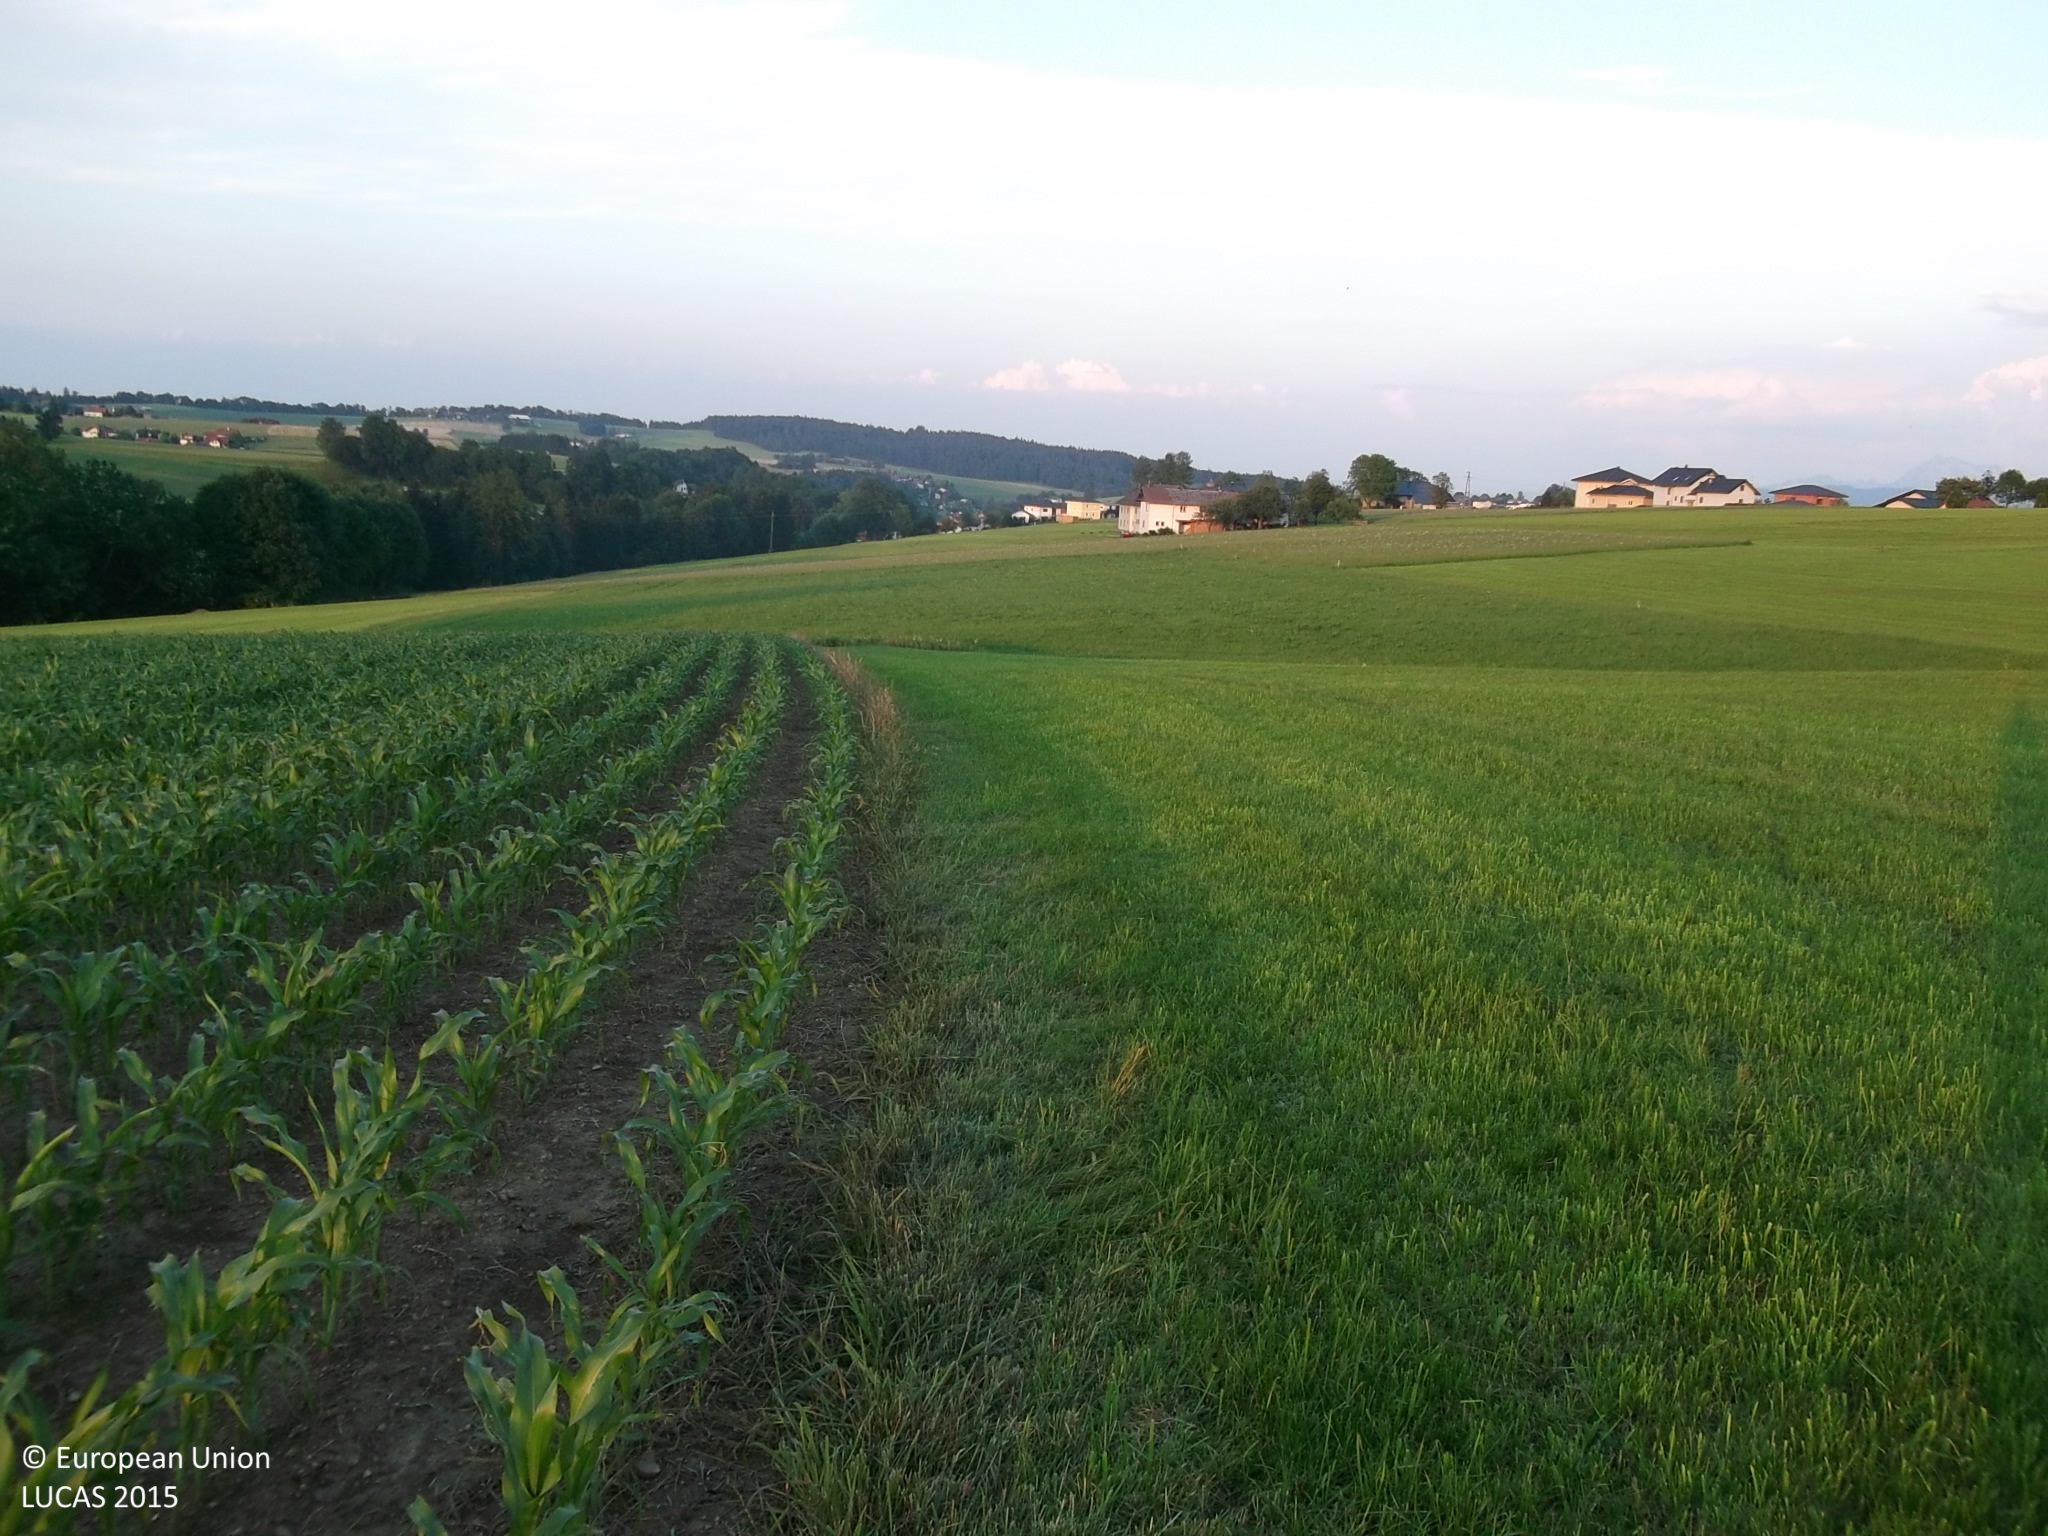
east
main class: Cropland
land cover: Maize
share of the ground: 50 - 75 %
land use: Agriculture (excluding fallow land and kitchen gardens)
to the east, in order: Maize; Grassland without tree/shrub cover; Ditches and canals; Grassland without tree/shrub cover; Tracks; Grassland without tree/shrub cover
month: June
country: AT
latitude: 48.0068
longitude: 13.4708
